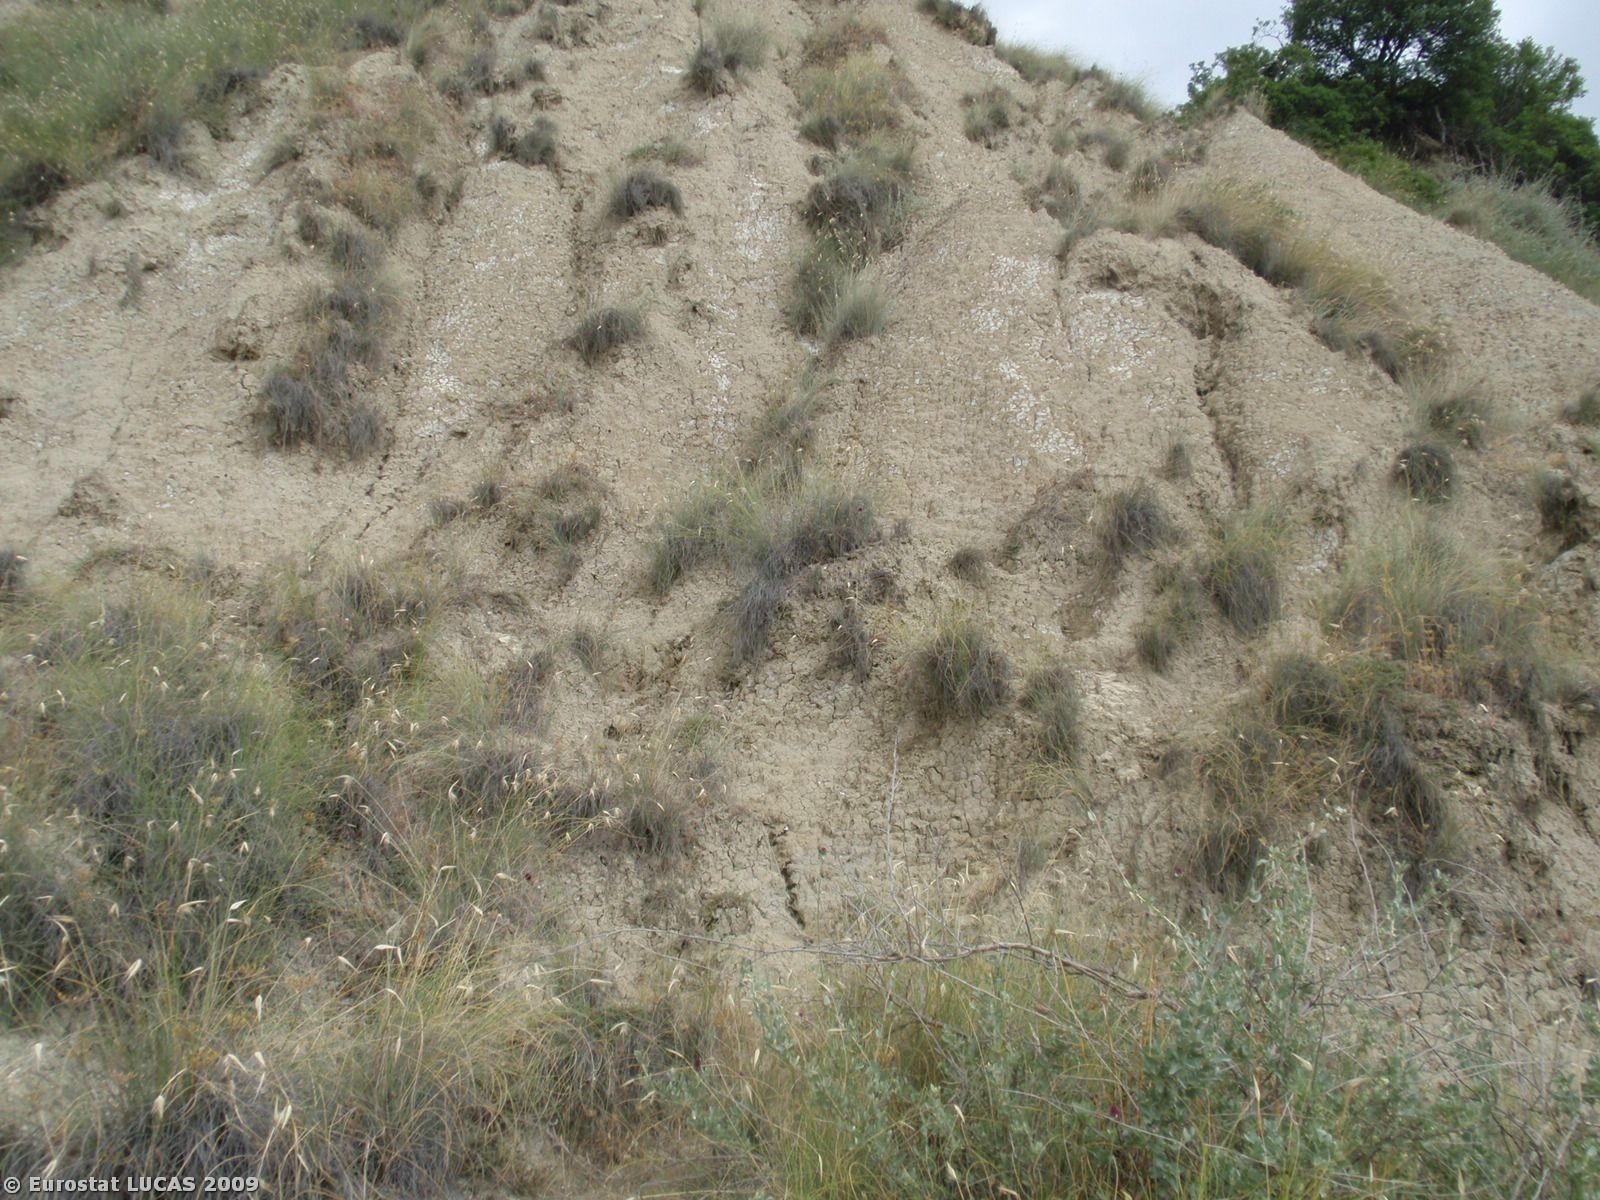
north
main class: Shrubland
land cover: Shrubland with sparse tree cover
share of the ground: > 75 %
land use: Agriculture (excluding fallow land and kitchen gardens)
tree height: < 5 m
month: June
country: IT
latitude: 40.2124
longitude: 16.2608
